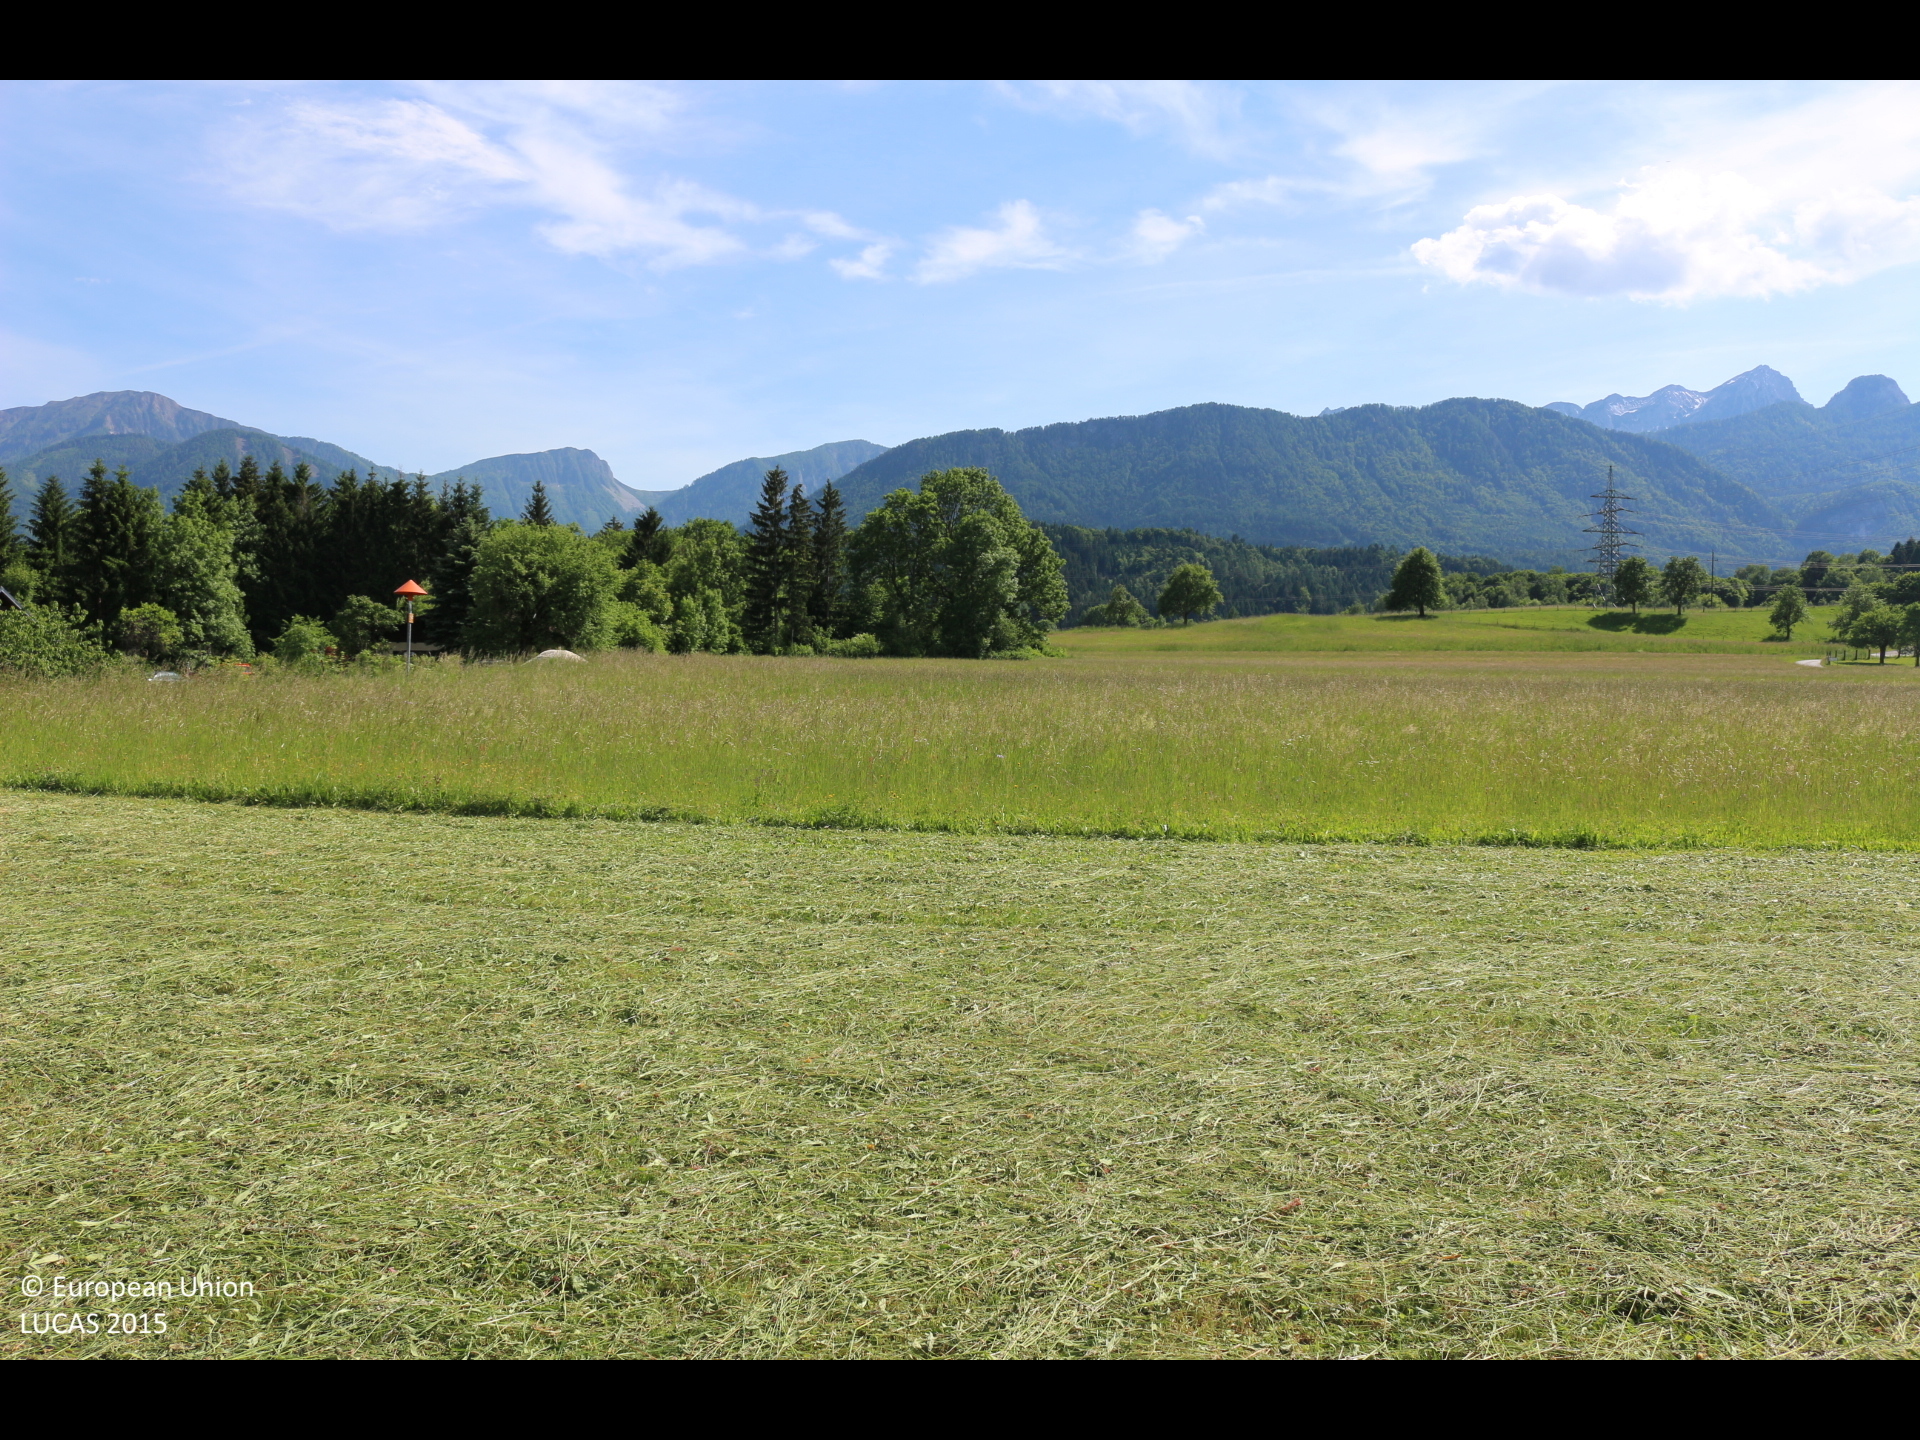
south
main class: Grassland
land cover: Grassland without tree/shrub cover
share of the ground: > 75 %
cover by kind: herbaceous plants 100 %
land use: Agriculture (excluding fallow land and kitchen gardens)
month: May
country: AT
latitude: 46.5639
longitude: 14.0283
